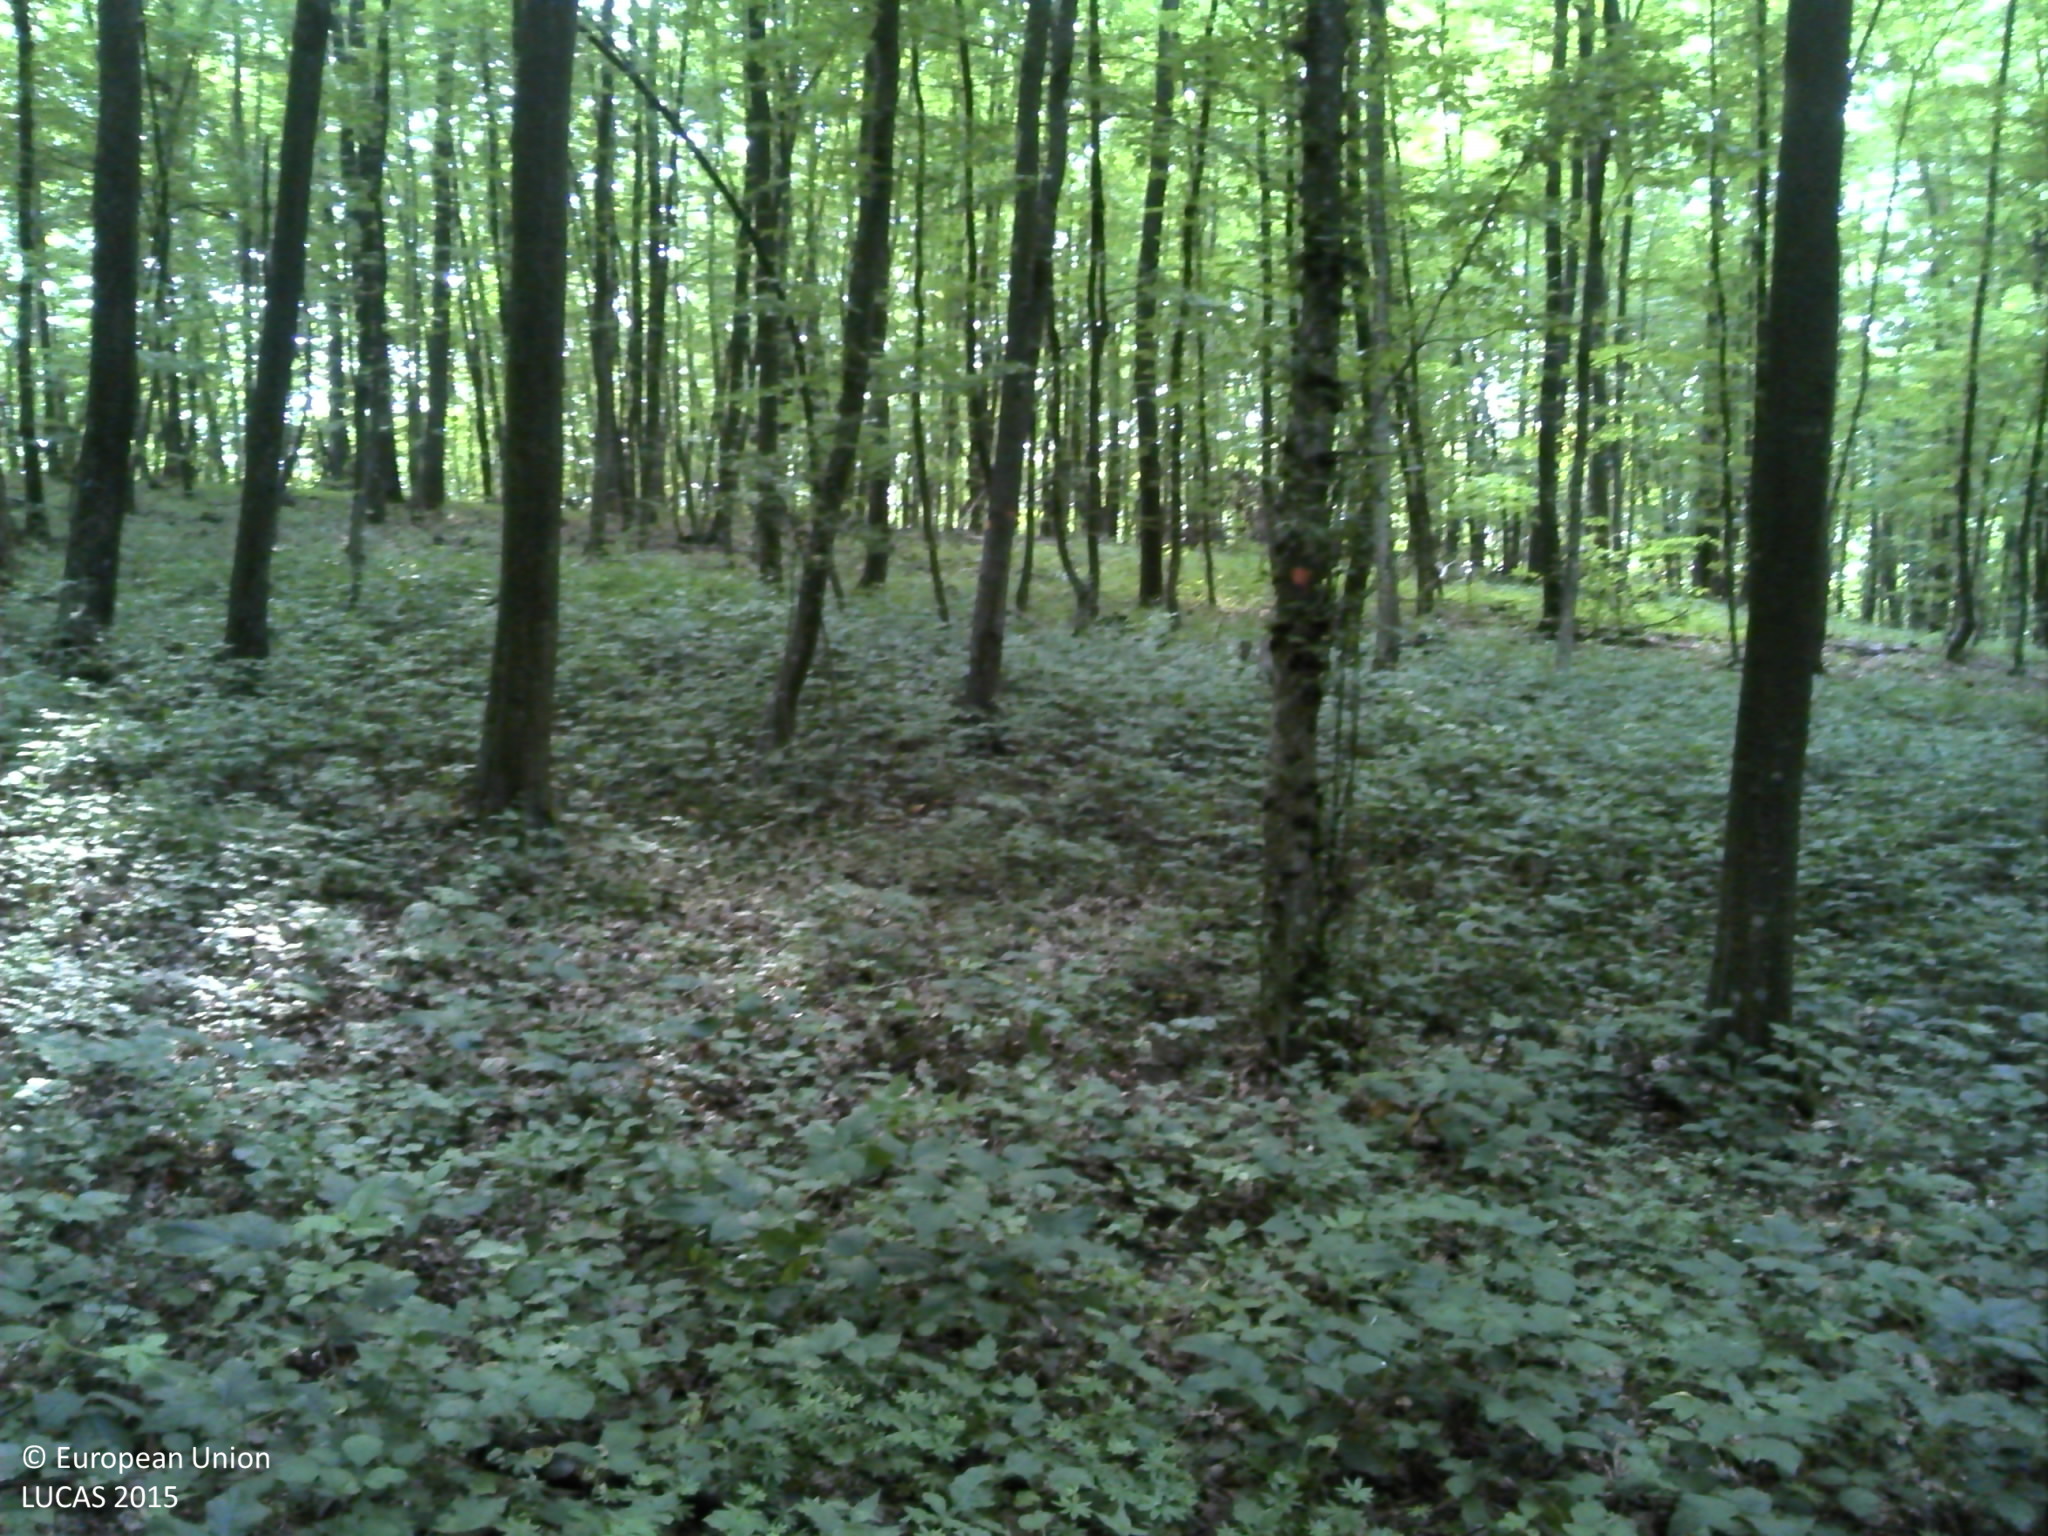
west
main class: Woodland
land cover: Broadleaved woodland
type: beech forest
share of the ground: > 75 %
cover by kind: broadleaved forest trees 90 %, herbaceous plants 5 %, lichens and mosses 5 %
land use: Forestry
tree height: > 5 m
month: June
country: HR
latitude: 45.2597
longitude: 18.1722
